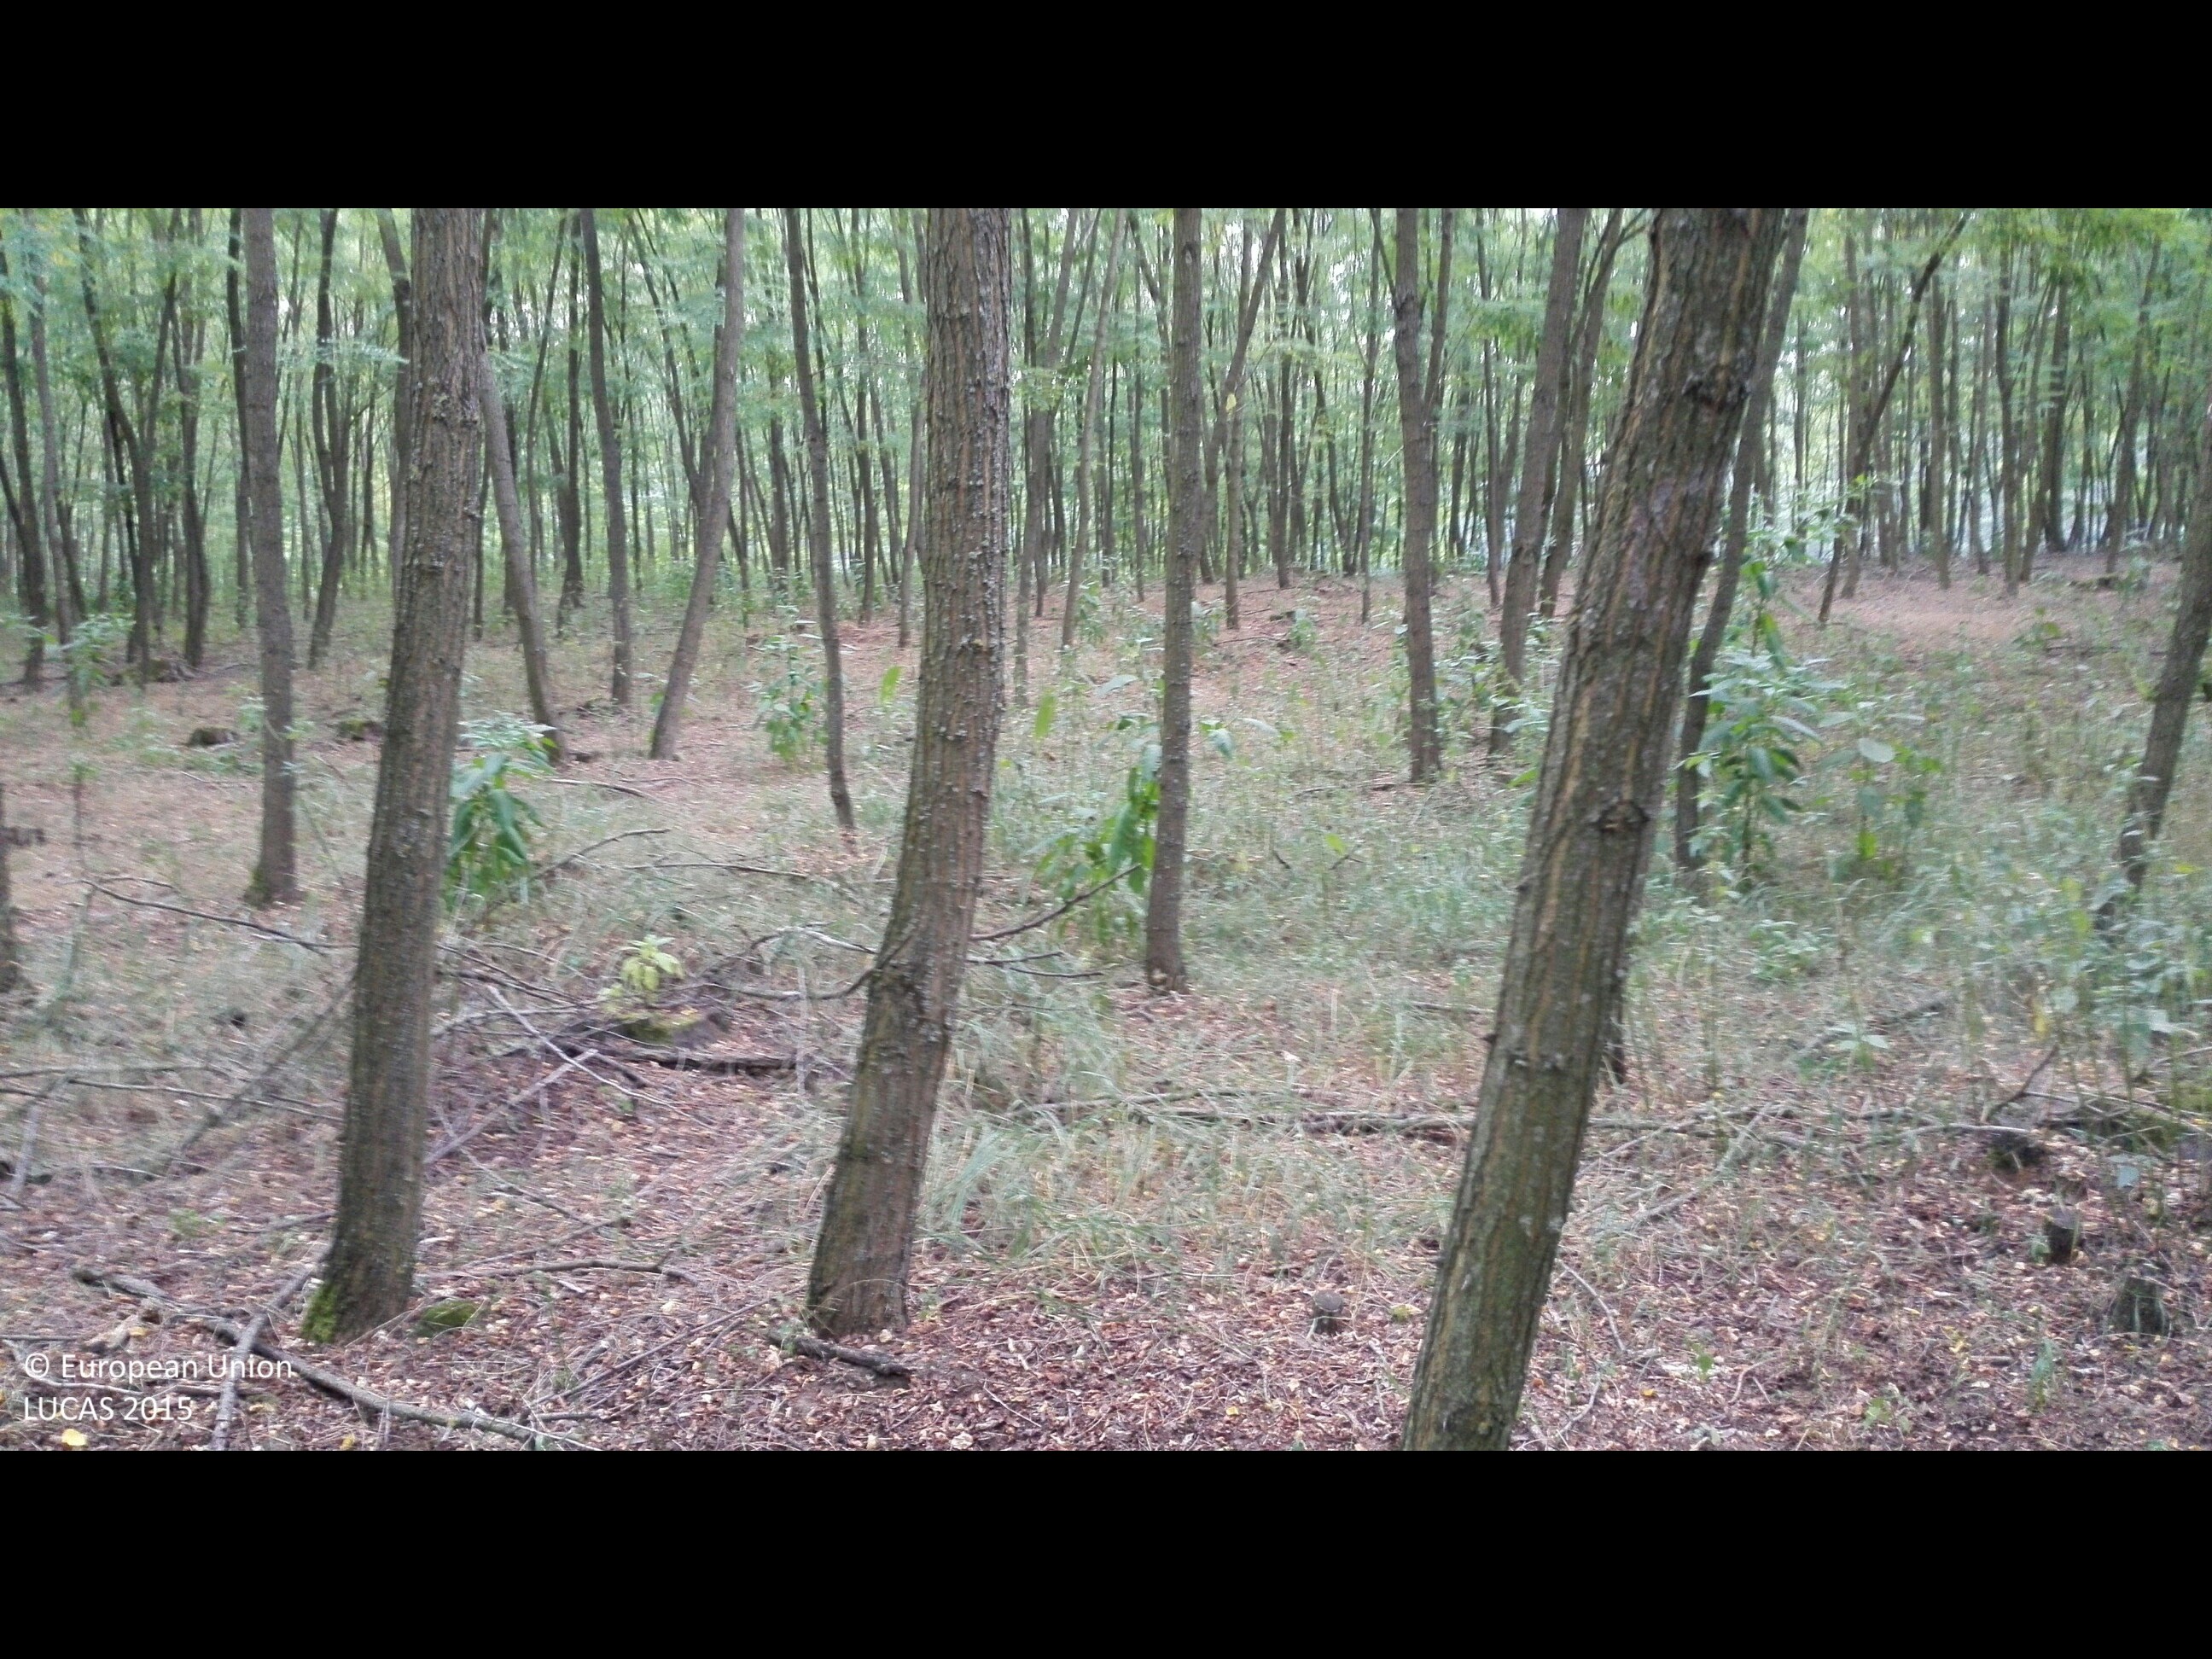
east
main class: Woodland
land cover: Broadleaved woodland
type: exotic forest
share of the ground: > 75 %
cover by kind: broadleaved forest trees 95 %, herbaceous plants 5 %
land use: Forestry
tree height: > 5 m
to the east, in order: Broadleaved woodland; Grassland without tree/shrub cover; Broadleaved woodland
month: August
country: HU
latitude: 47.6392
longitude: 21.9895
